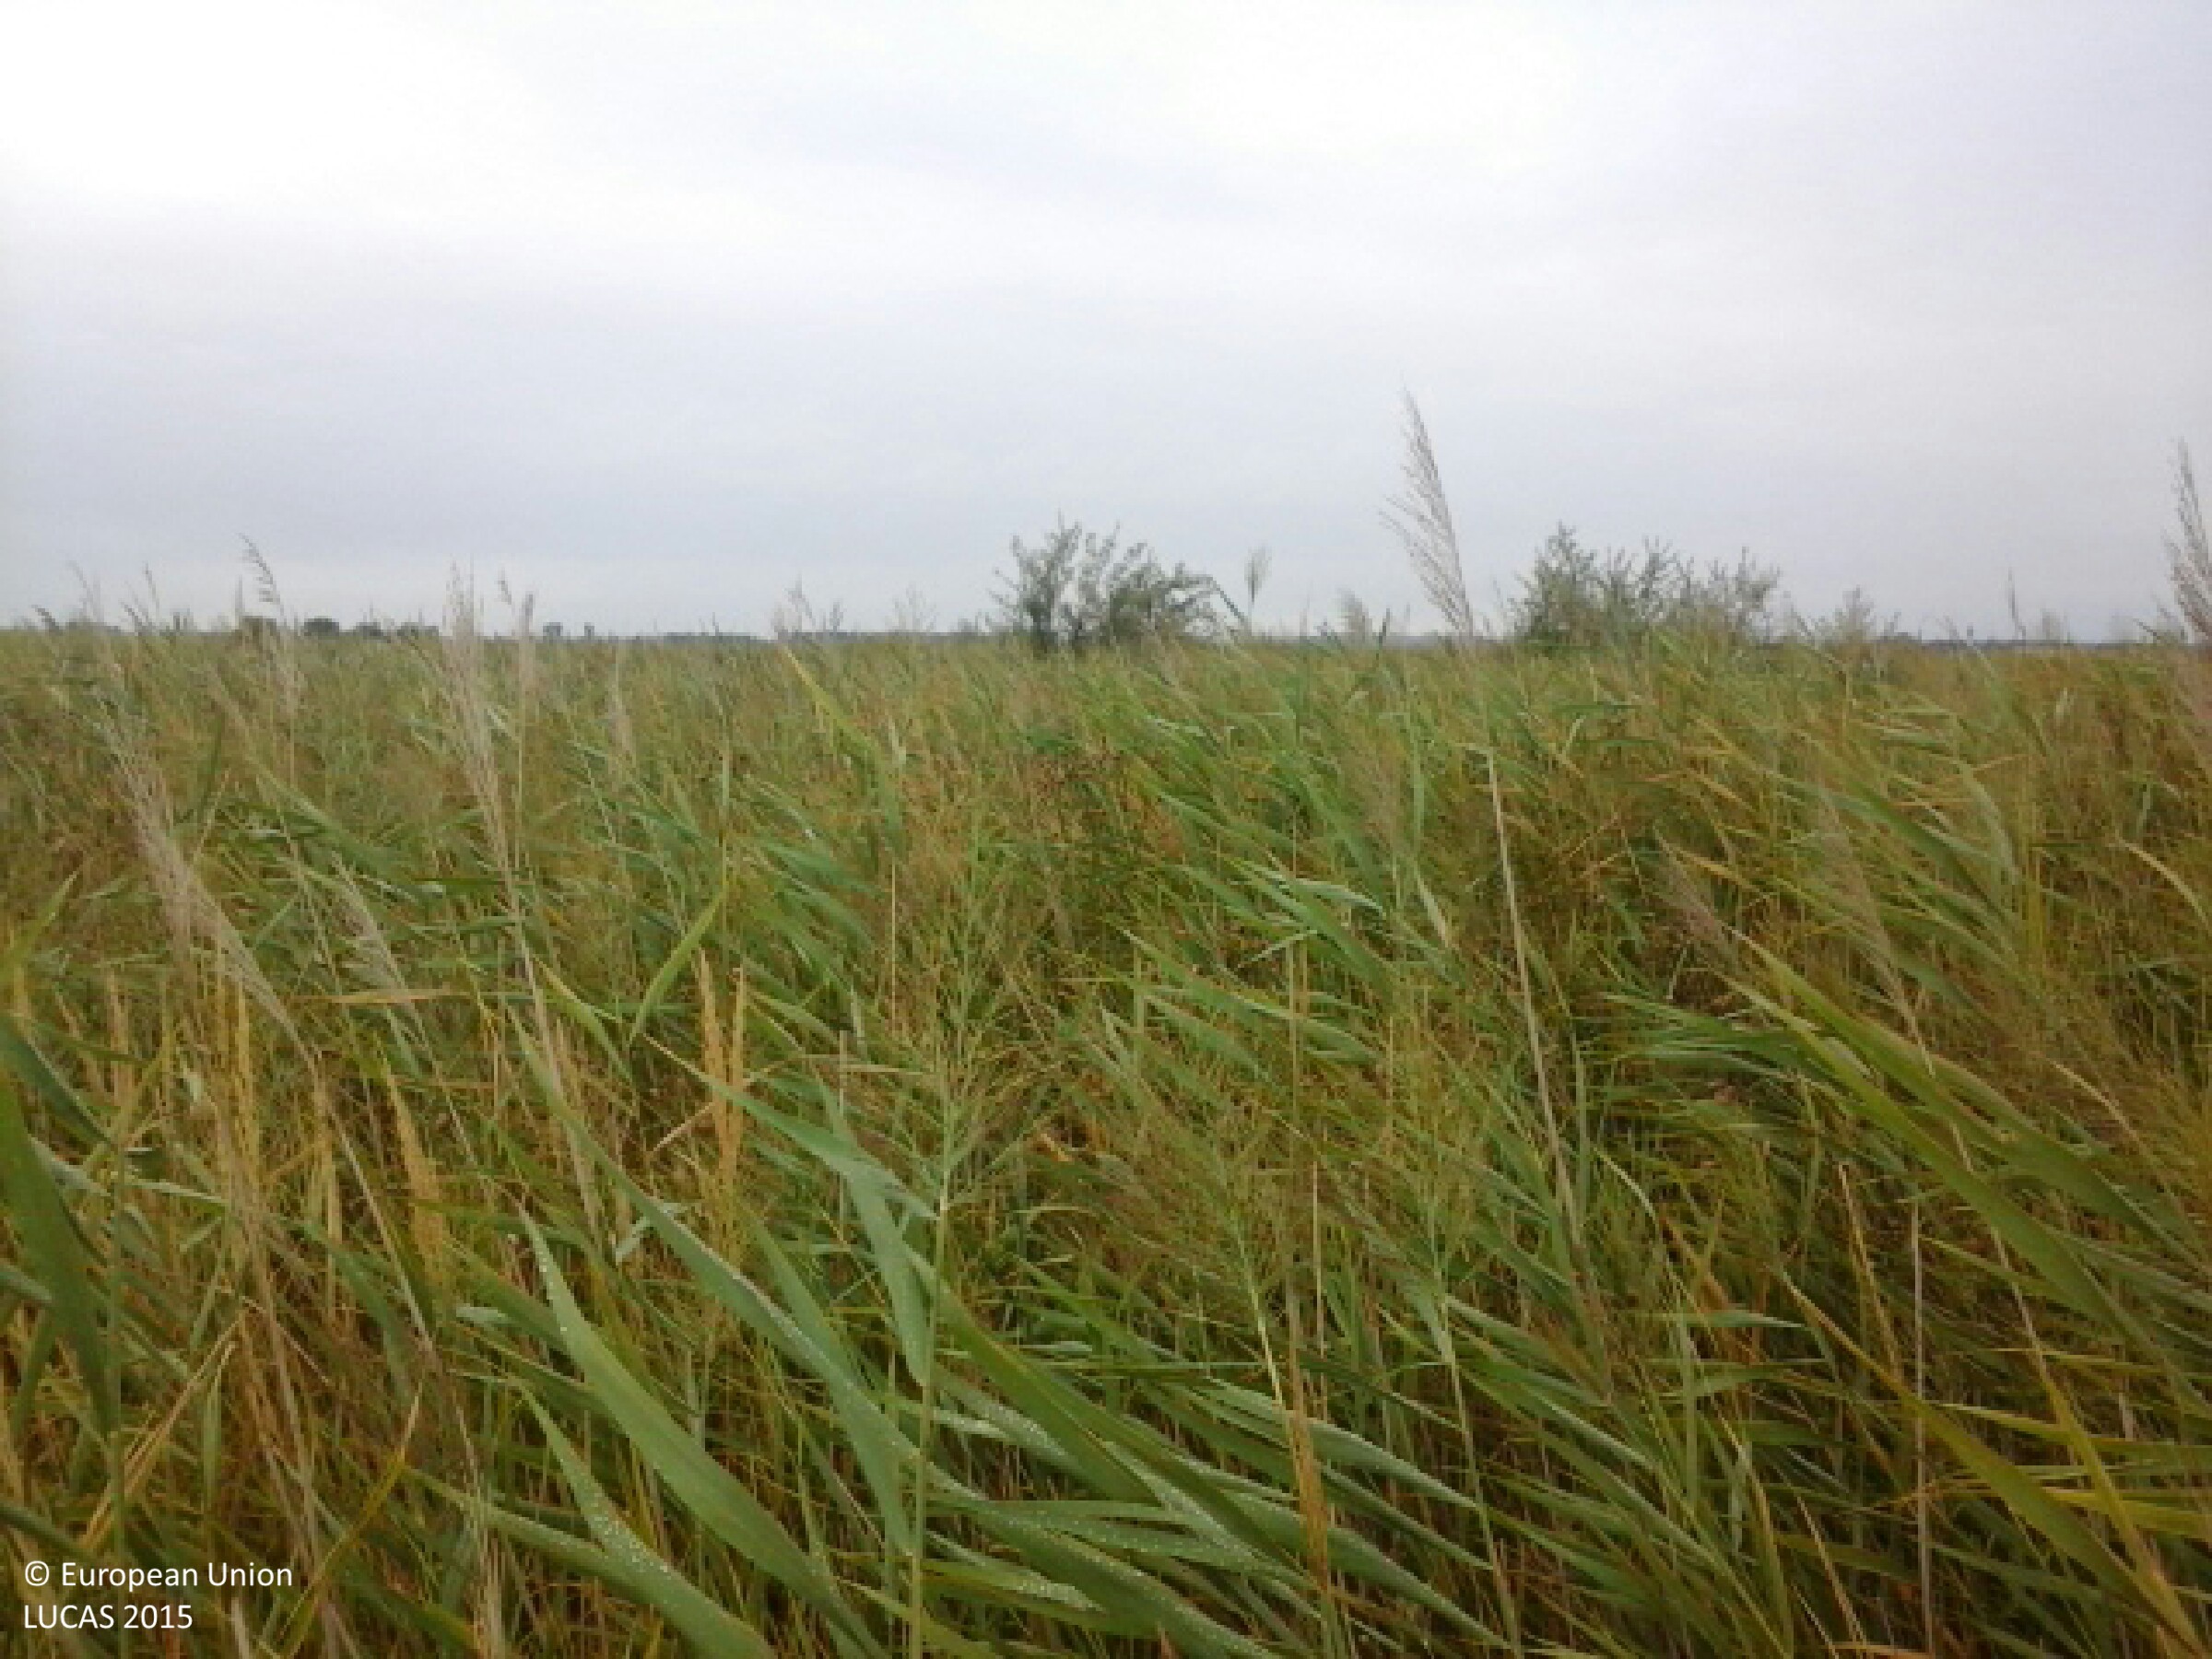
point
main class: Grassland
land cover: Grassland without tree/shrub cover
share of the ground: > 75 %
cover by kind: herbaceous plants 100 %
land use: Agriculture (excluding fallow land and kitchen gardens)
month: August
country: HU
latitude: 48.0390
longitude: 21.4861
